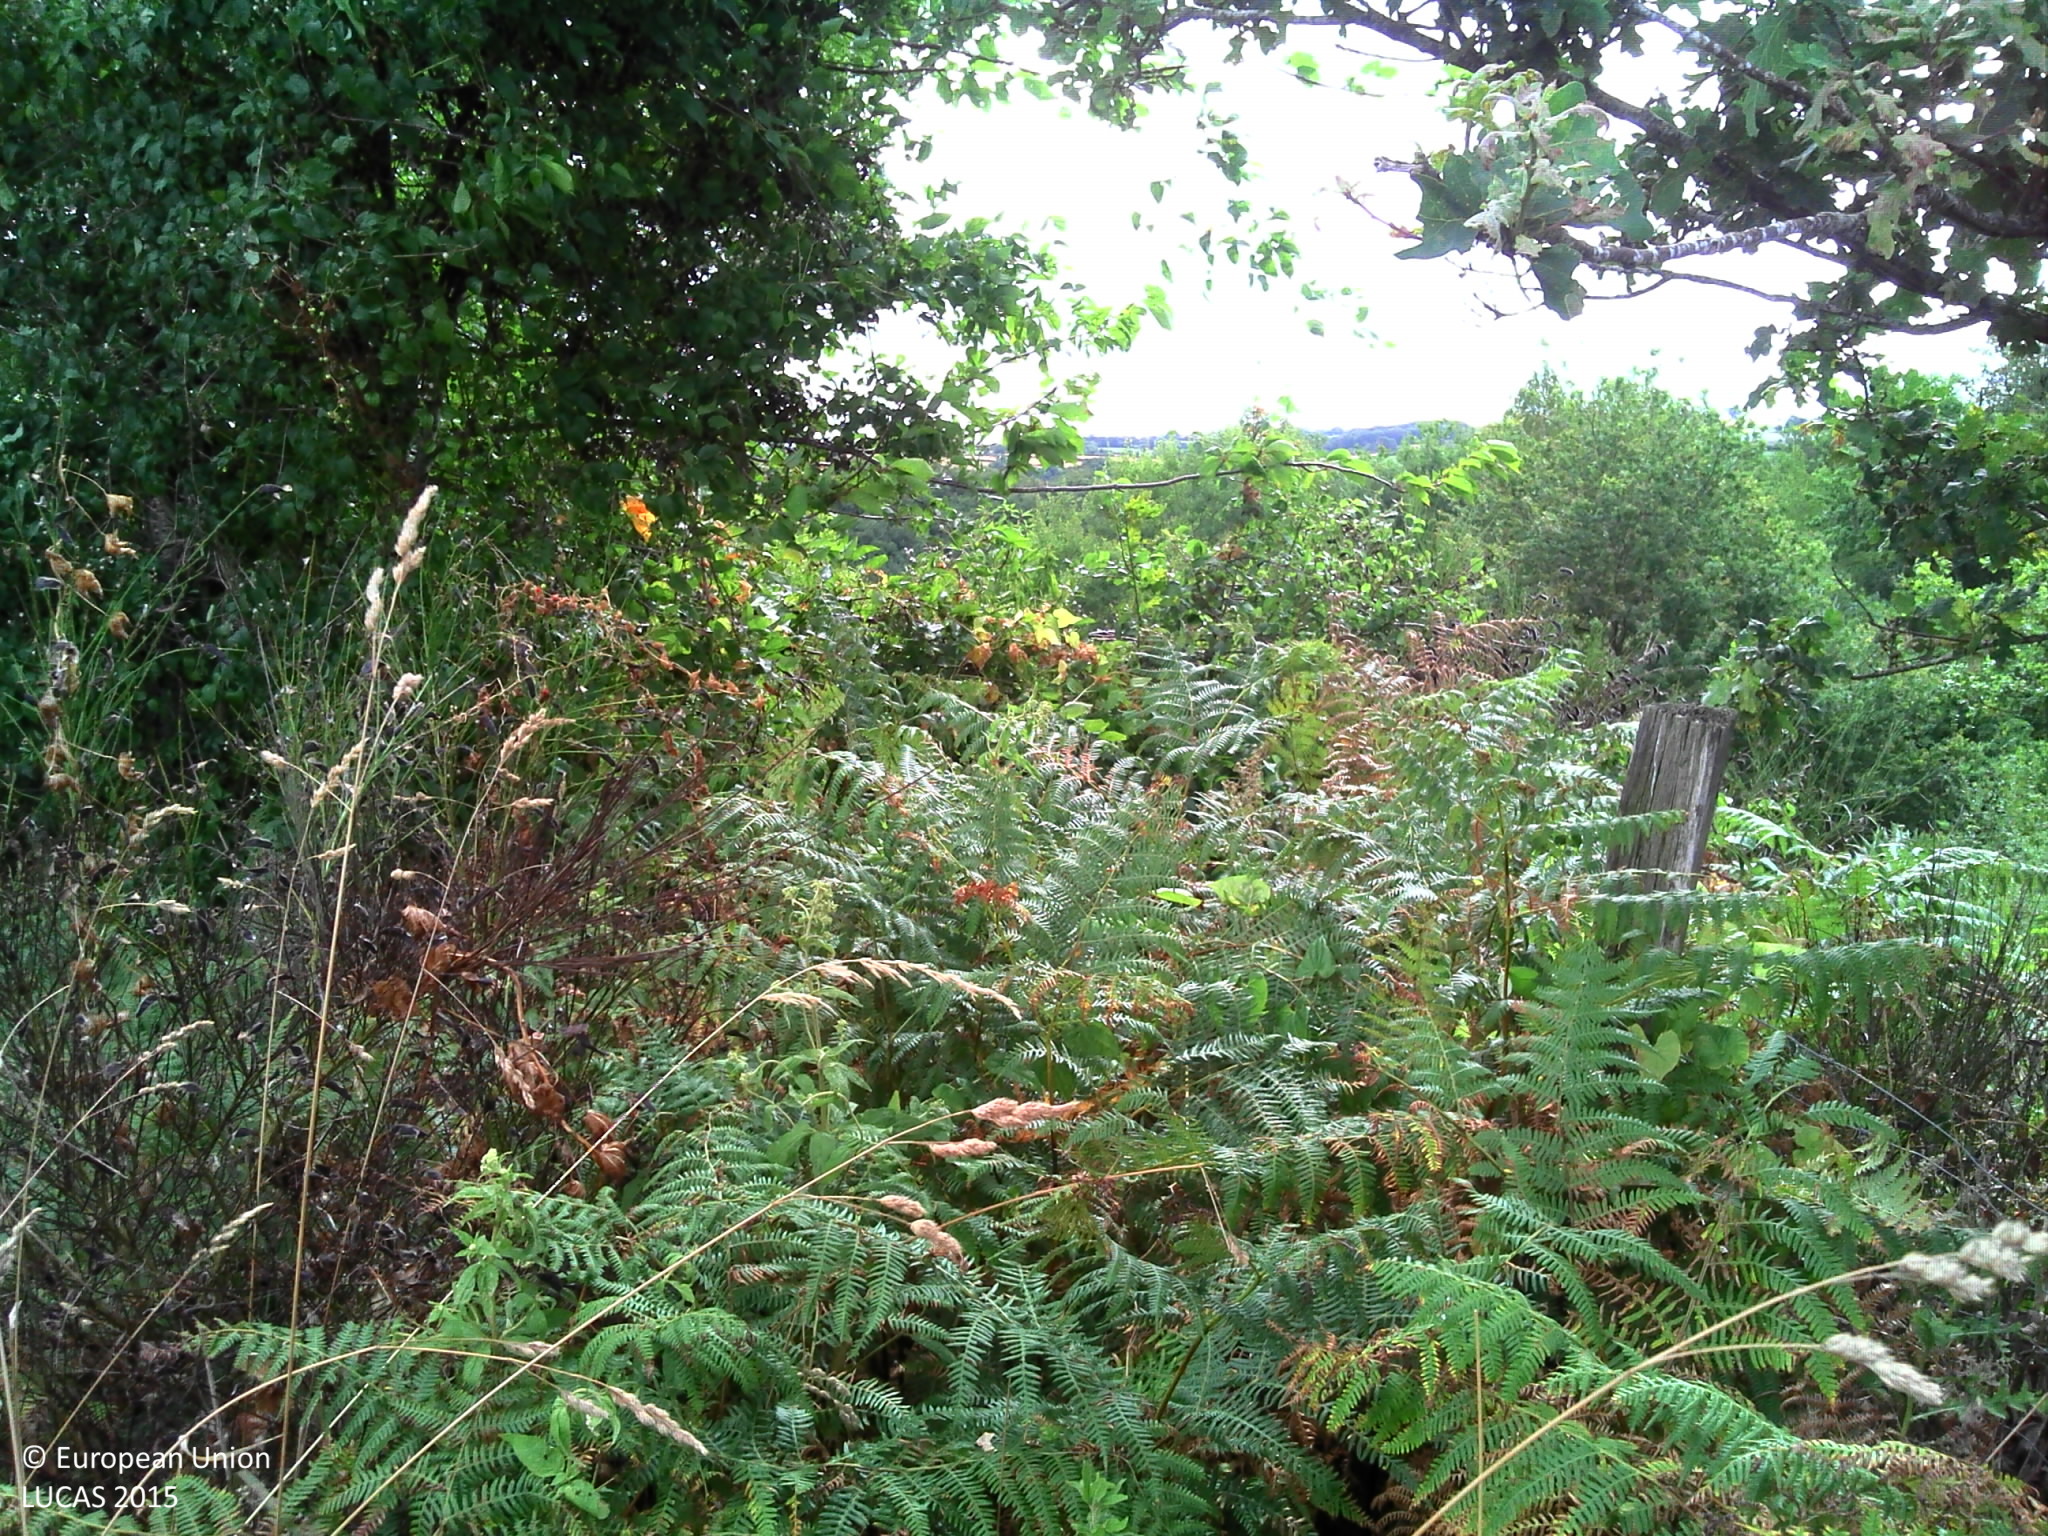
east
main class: Grassland
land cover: Grassland without tree/shrub cover
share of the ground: > 75 %
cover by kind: herbaceous plants 100 %
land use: Agriculture (excluding fallow land and kitchen gardens)
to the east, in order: Grassland without tree/shrub cover; Shrubland with sparse tree cover; Fences; Tracks; Shrubland with sparse tree cover; Abandoned hedges; Tracks; Abandoned hedges; Tracks; Broadleaved woodland; Artificial constructions in urban areas; Spruce dominated mixed woodland; Rock outcrops; Spruce dominated mixed woodland; Fences; Spruce dominated mixed woodland
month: July
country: FR
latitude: 44.0448
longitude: 2.5289
